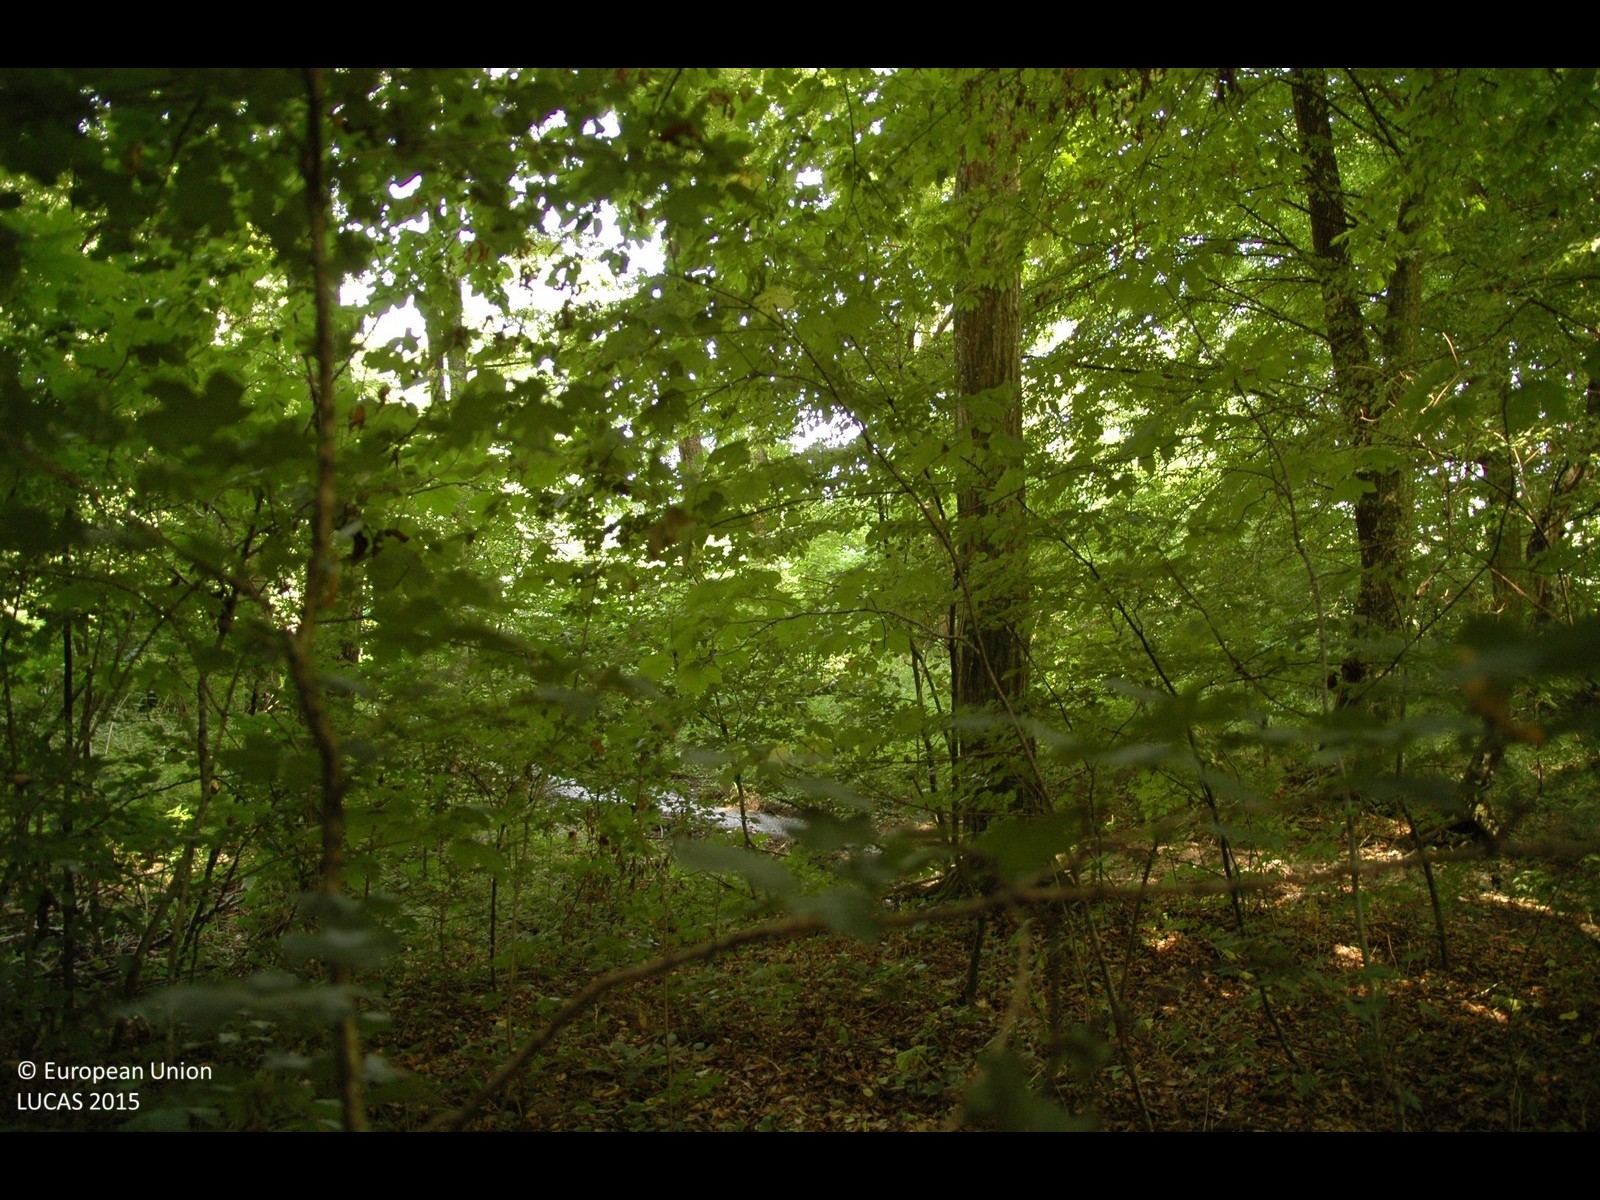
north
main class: Woodland
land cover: Broadleaved woodland
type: mesophytic deciduous forest
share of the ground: > 75 %
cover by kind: broadleaved forest trees 100 %
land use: Forestry
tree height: > 5 m
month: July
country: HR
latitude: 46.1626
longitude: 16.6442
